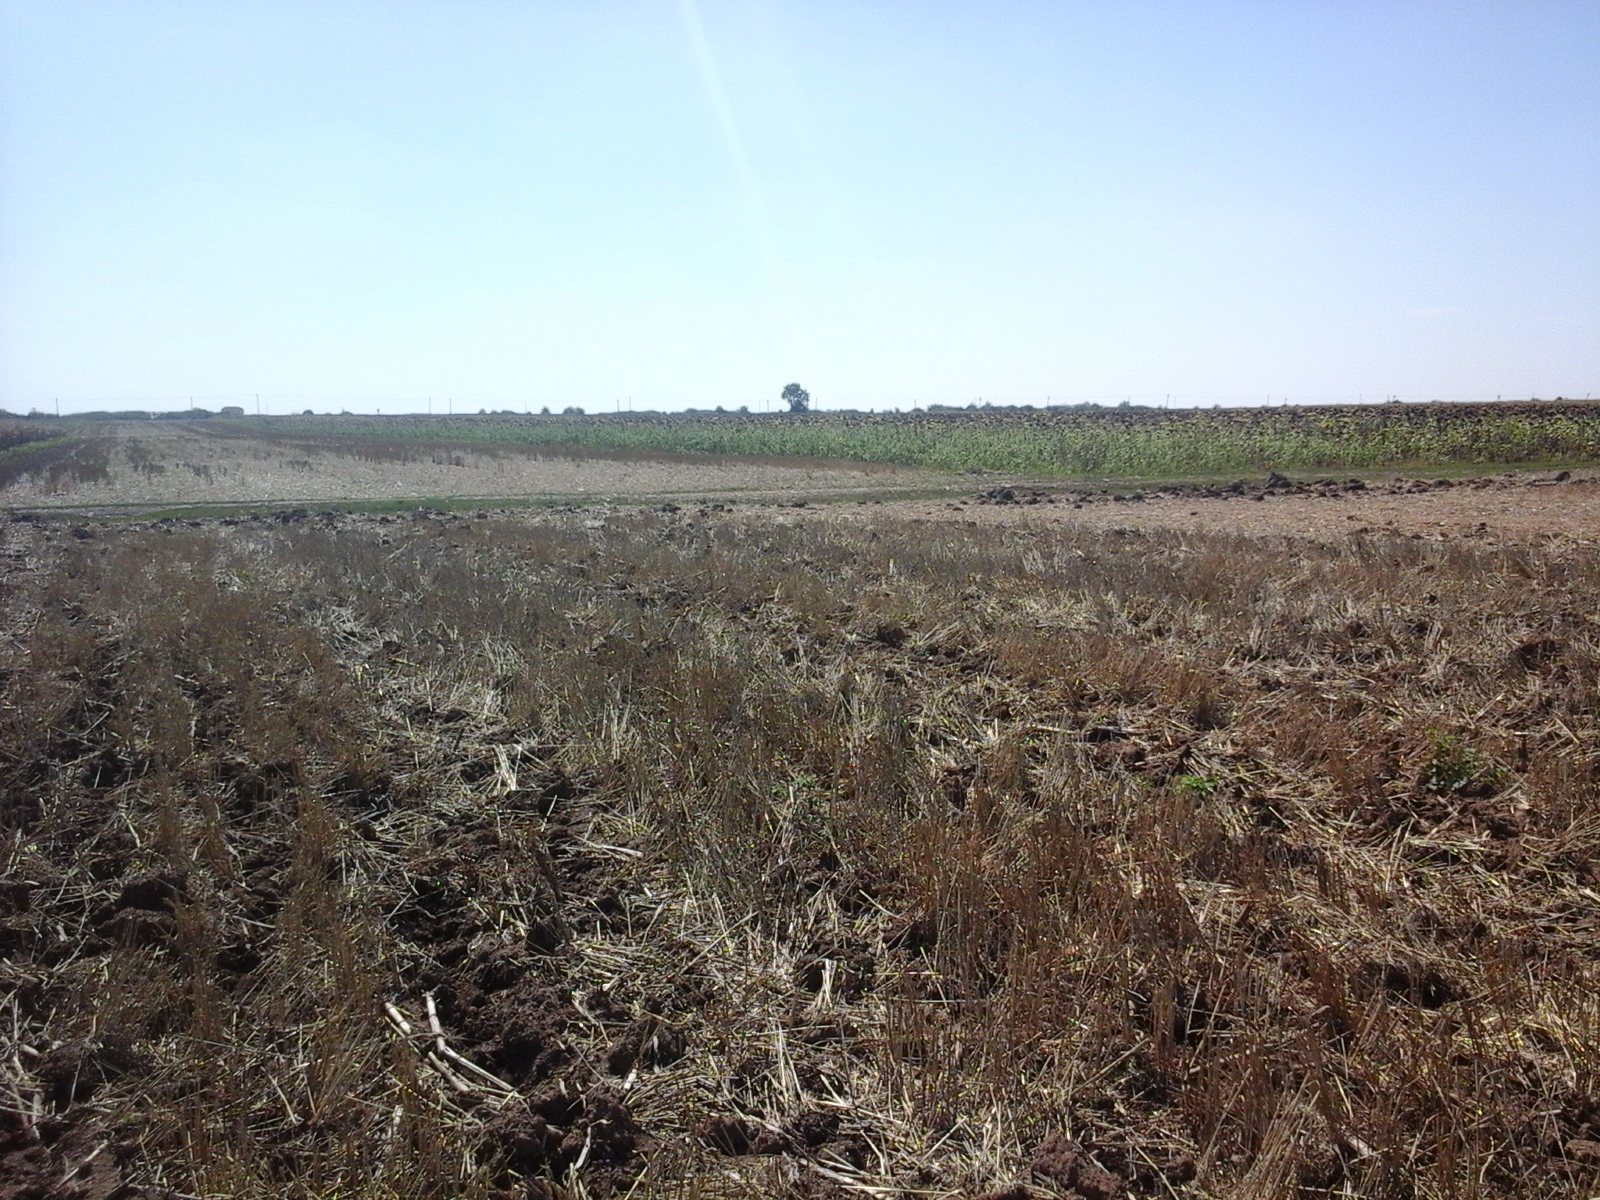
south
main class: Cropland
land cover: Common wheat
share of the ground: 50 - 75 %
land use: Agriculture (excluding fallow land and kitchen gardens)
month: August
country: RO
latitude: 46.1148
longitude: 21.1202
